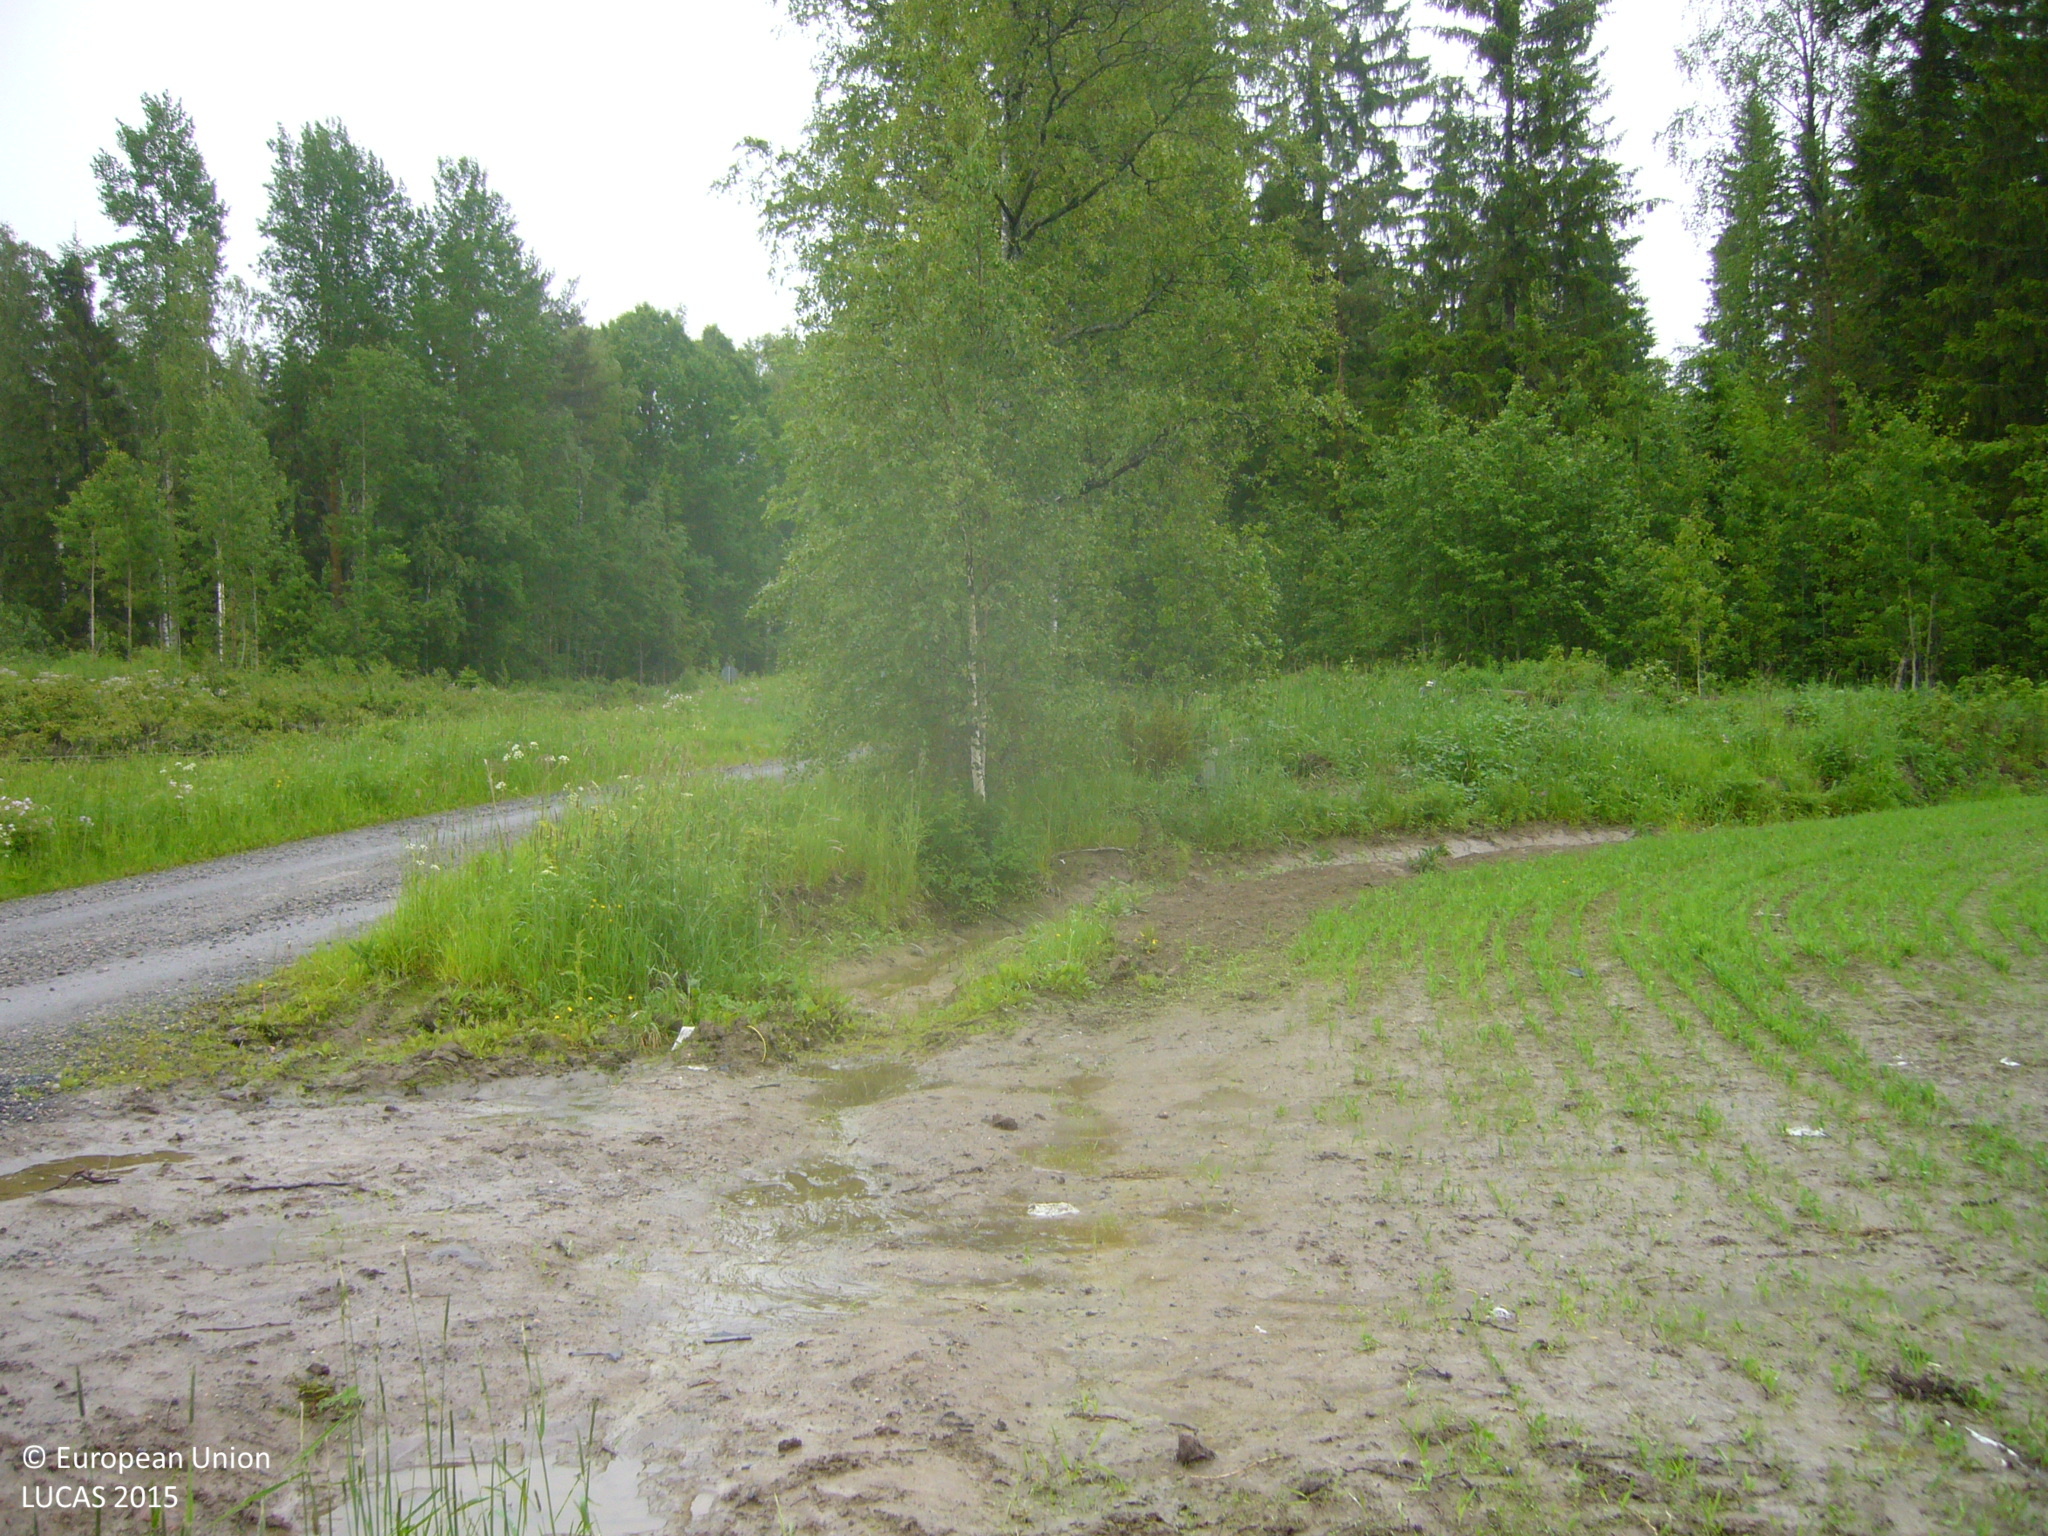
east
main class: Cropland
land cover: Barley
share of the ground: > 75 %
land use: Agriculture (excluding fallow land and kitchen gardens)
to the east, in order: Barley; Ditches and canals; Spontaneously vegetated surfaces; Spruce dominated mixed woodland; Paved roads, cycling and walking lanes; Grass margins; Ditches and canals; Other mixed woodland; Ditches and canals; Spontaneously vegetated surfaces; Railways; Spontaneously vegetated surfaces; Other mixed woodland
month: June
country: FI
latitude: 63.6585
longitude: 26.4655
